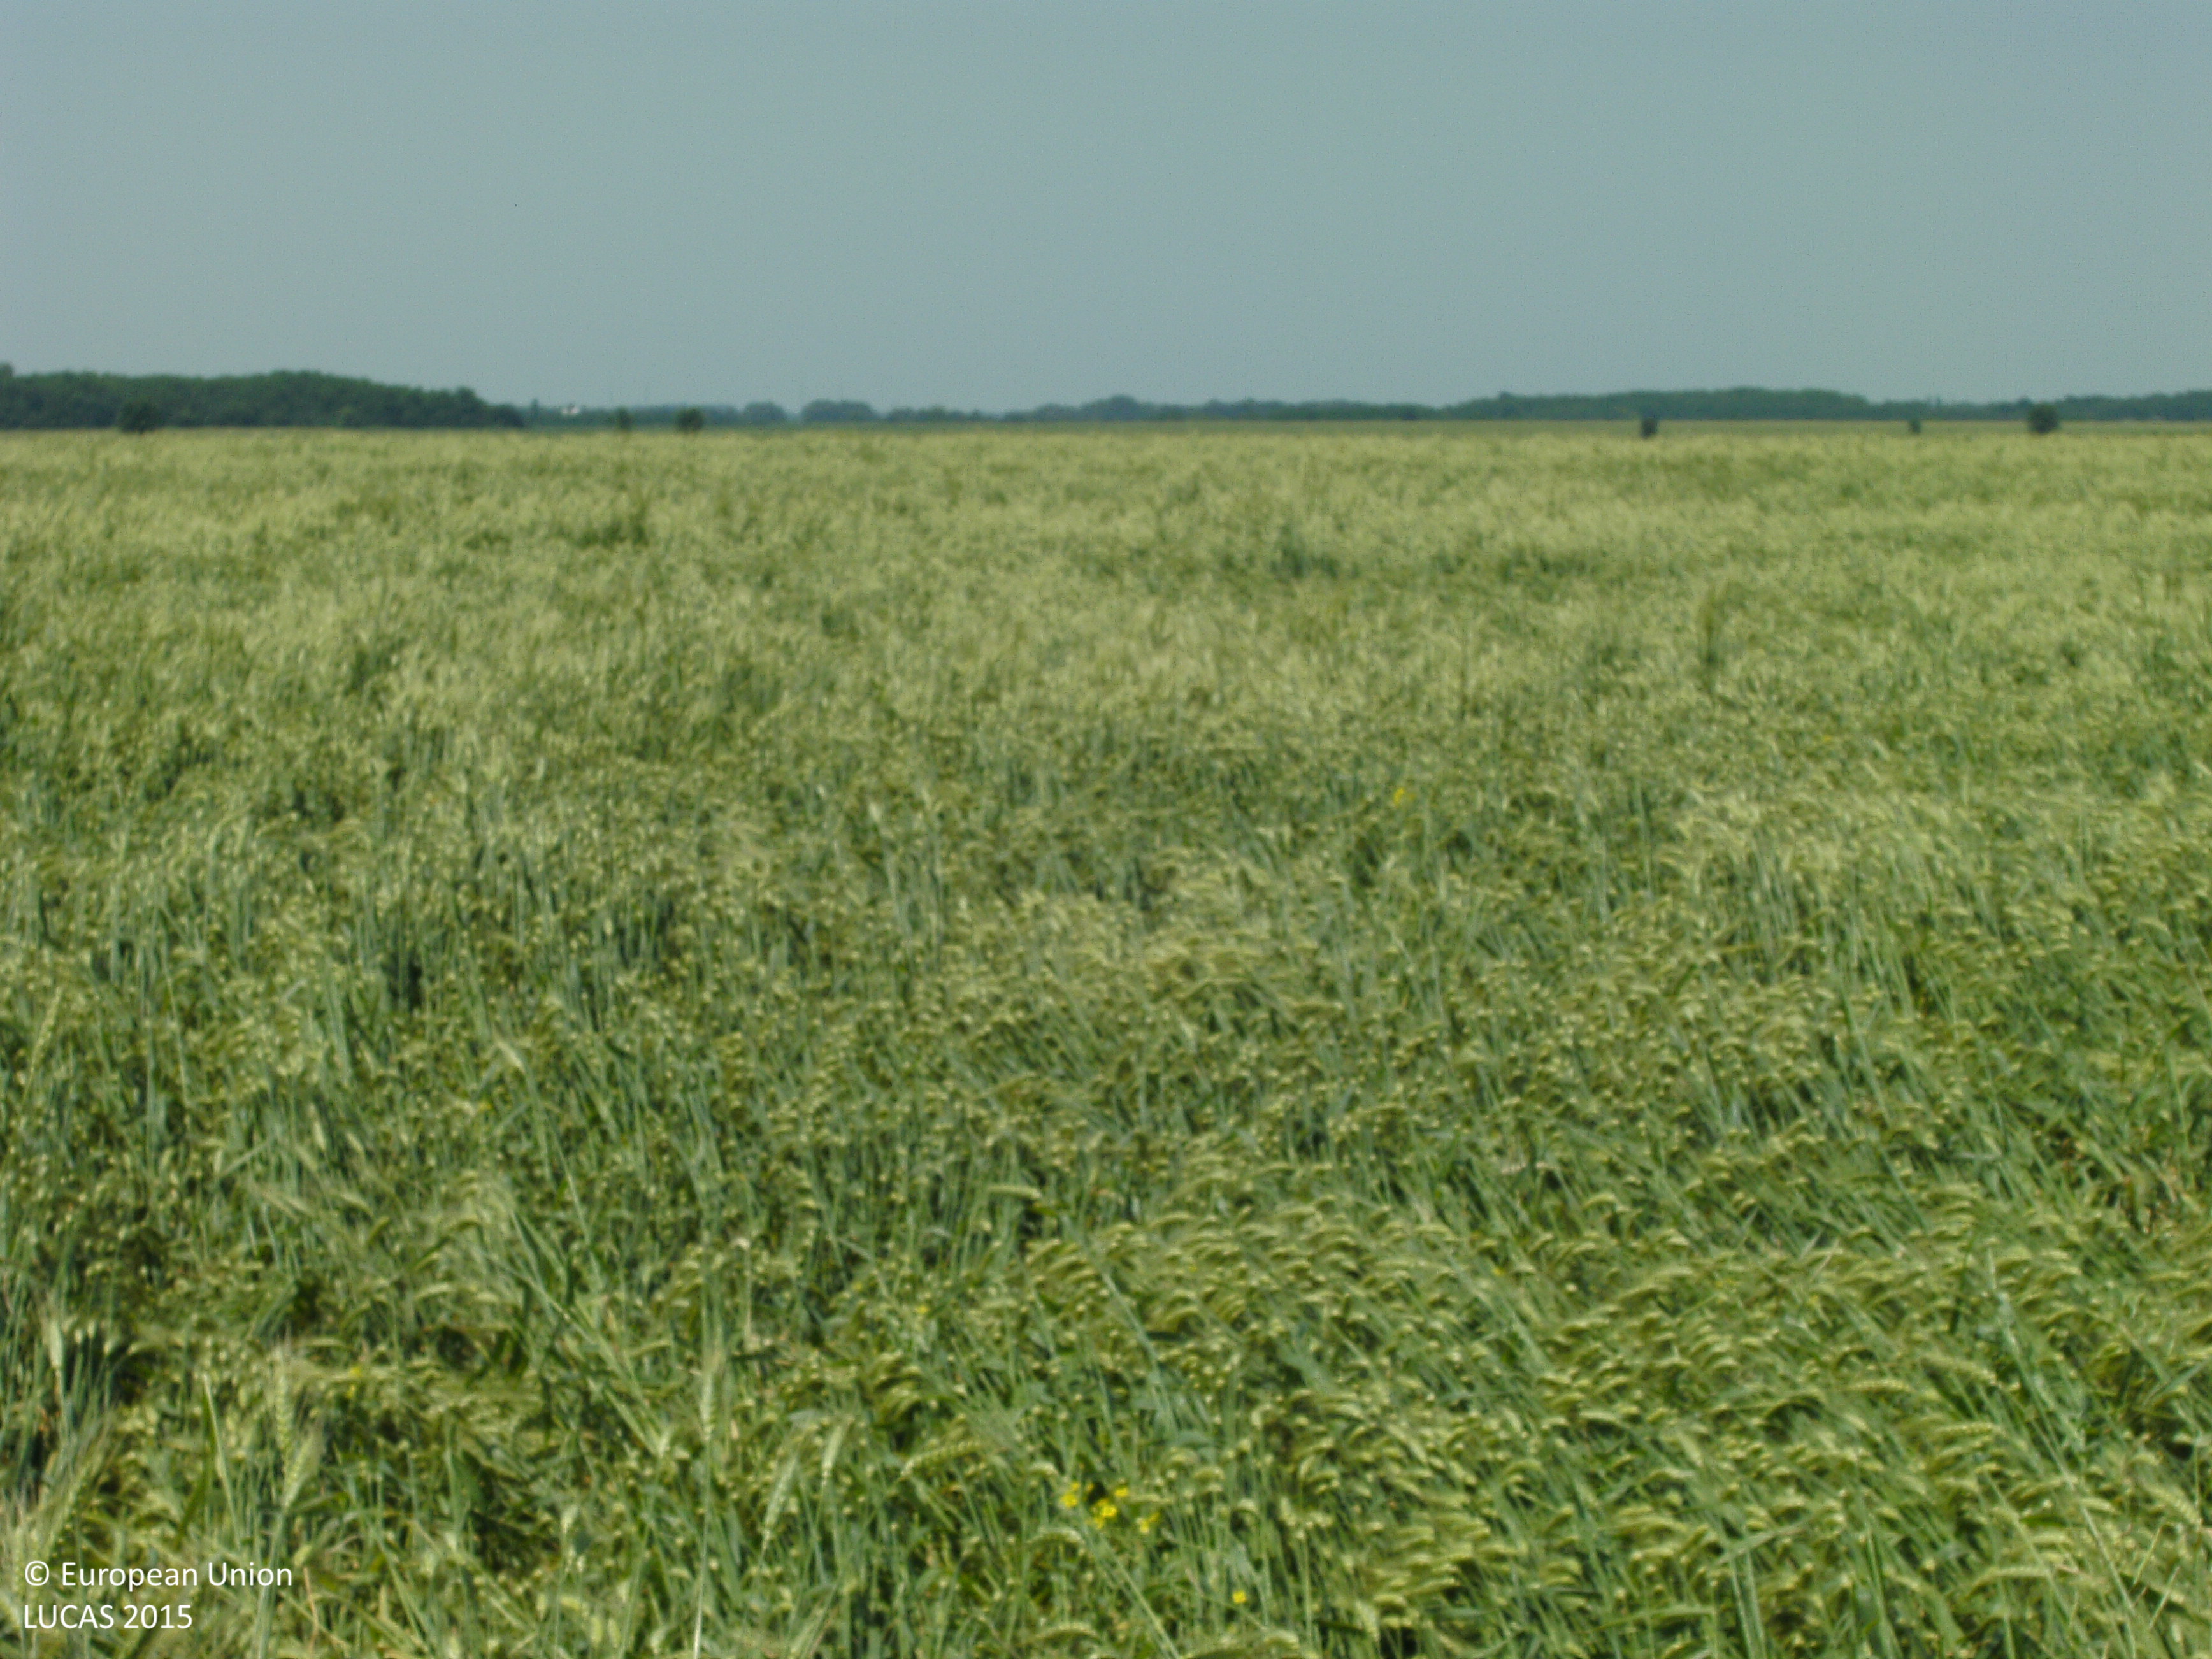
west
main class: Cropland
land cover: Common wheat
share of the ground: > 75 %
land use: Agriculture (excluding fallow land and kitchen gardens)
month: June
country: HU
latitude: 46.3787
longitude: 17.9767
